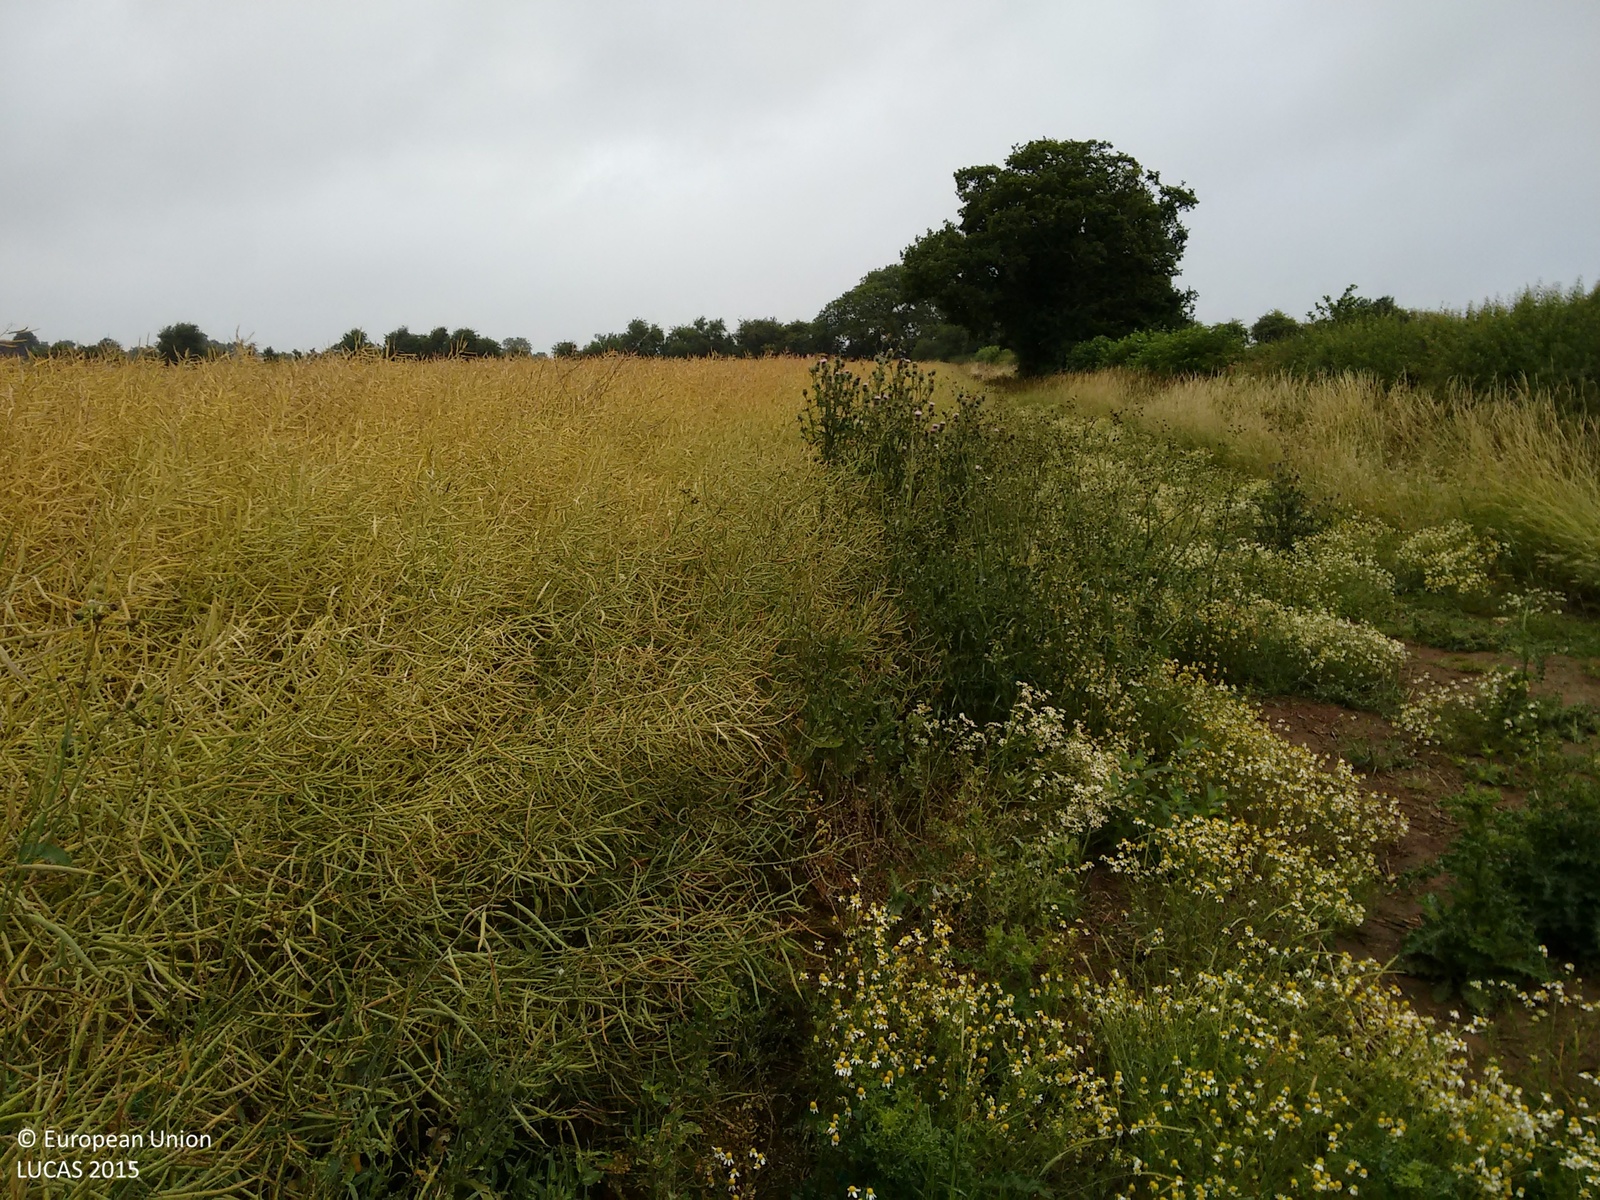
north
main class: Cropland
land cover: Rape and turnip rape
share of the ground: > 75 %
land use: Agriculture (excluding fallow land and kitchen gardens)
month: July
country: GB
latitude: 52.9348
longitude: -1.5824
